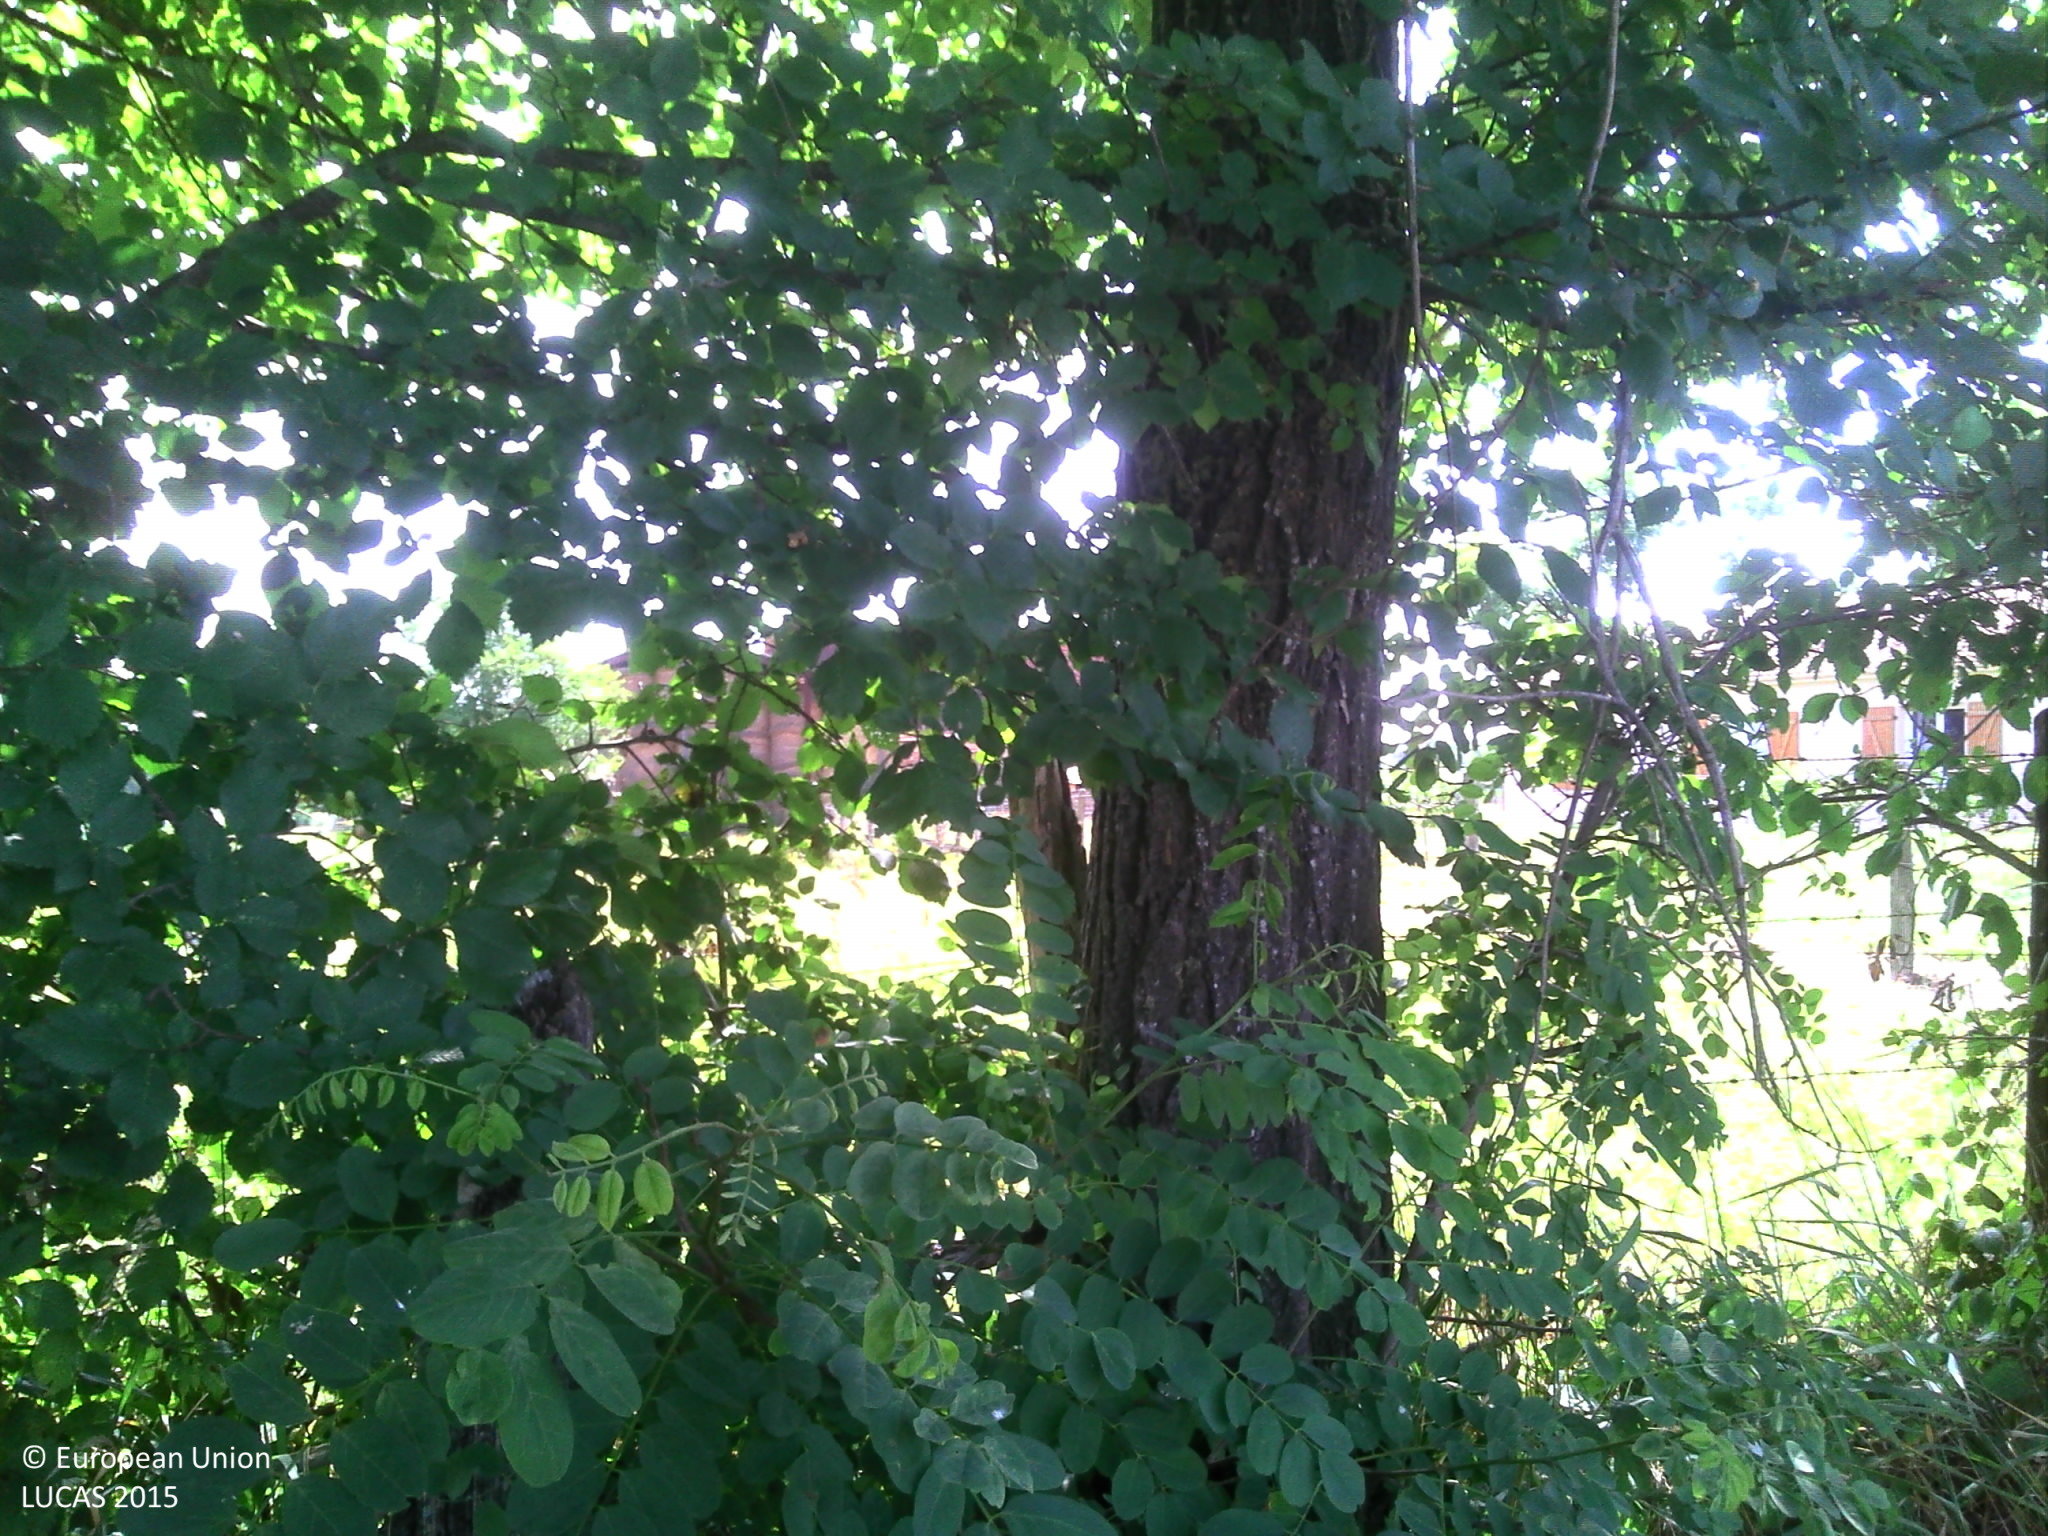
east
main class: Grassland
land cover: Grassland without tree/shrub cover
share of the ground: > 75 %
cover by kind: herbaceous plants 100 %
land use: Agriculture (excluding fallow land and kitchen gardens)
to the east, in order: Grass margins; Managed hedges; Fences; Grassland without tree/shrub cover; Artificial constructions in urban areas; Grassland without tree/shrub cover; Electric lines; Fences; Grass margins; Paved roads, cycling and walking lanes; Grass margins; Electric lines; Fences; Grassland without tree/shrub cover; Fences; Managed hedges; Broadleaved woodland
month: June
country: FR
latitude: 46.3638
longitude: 4.0086
